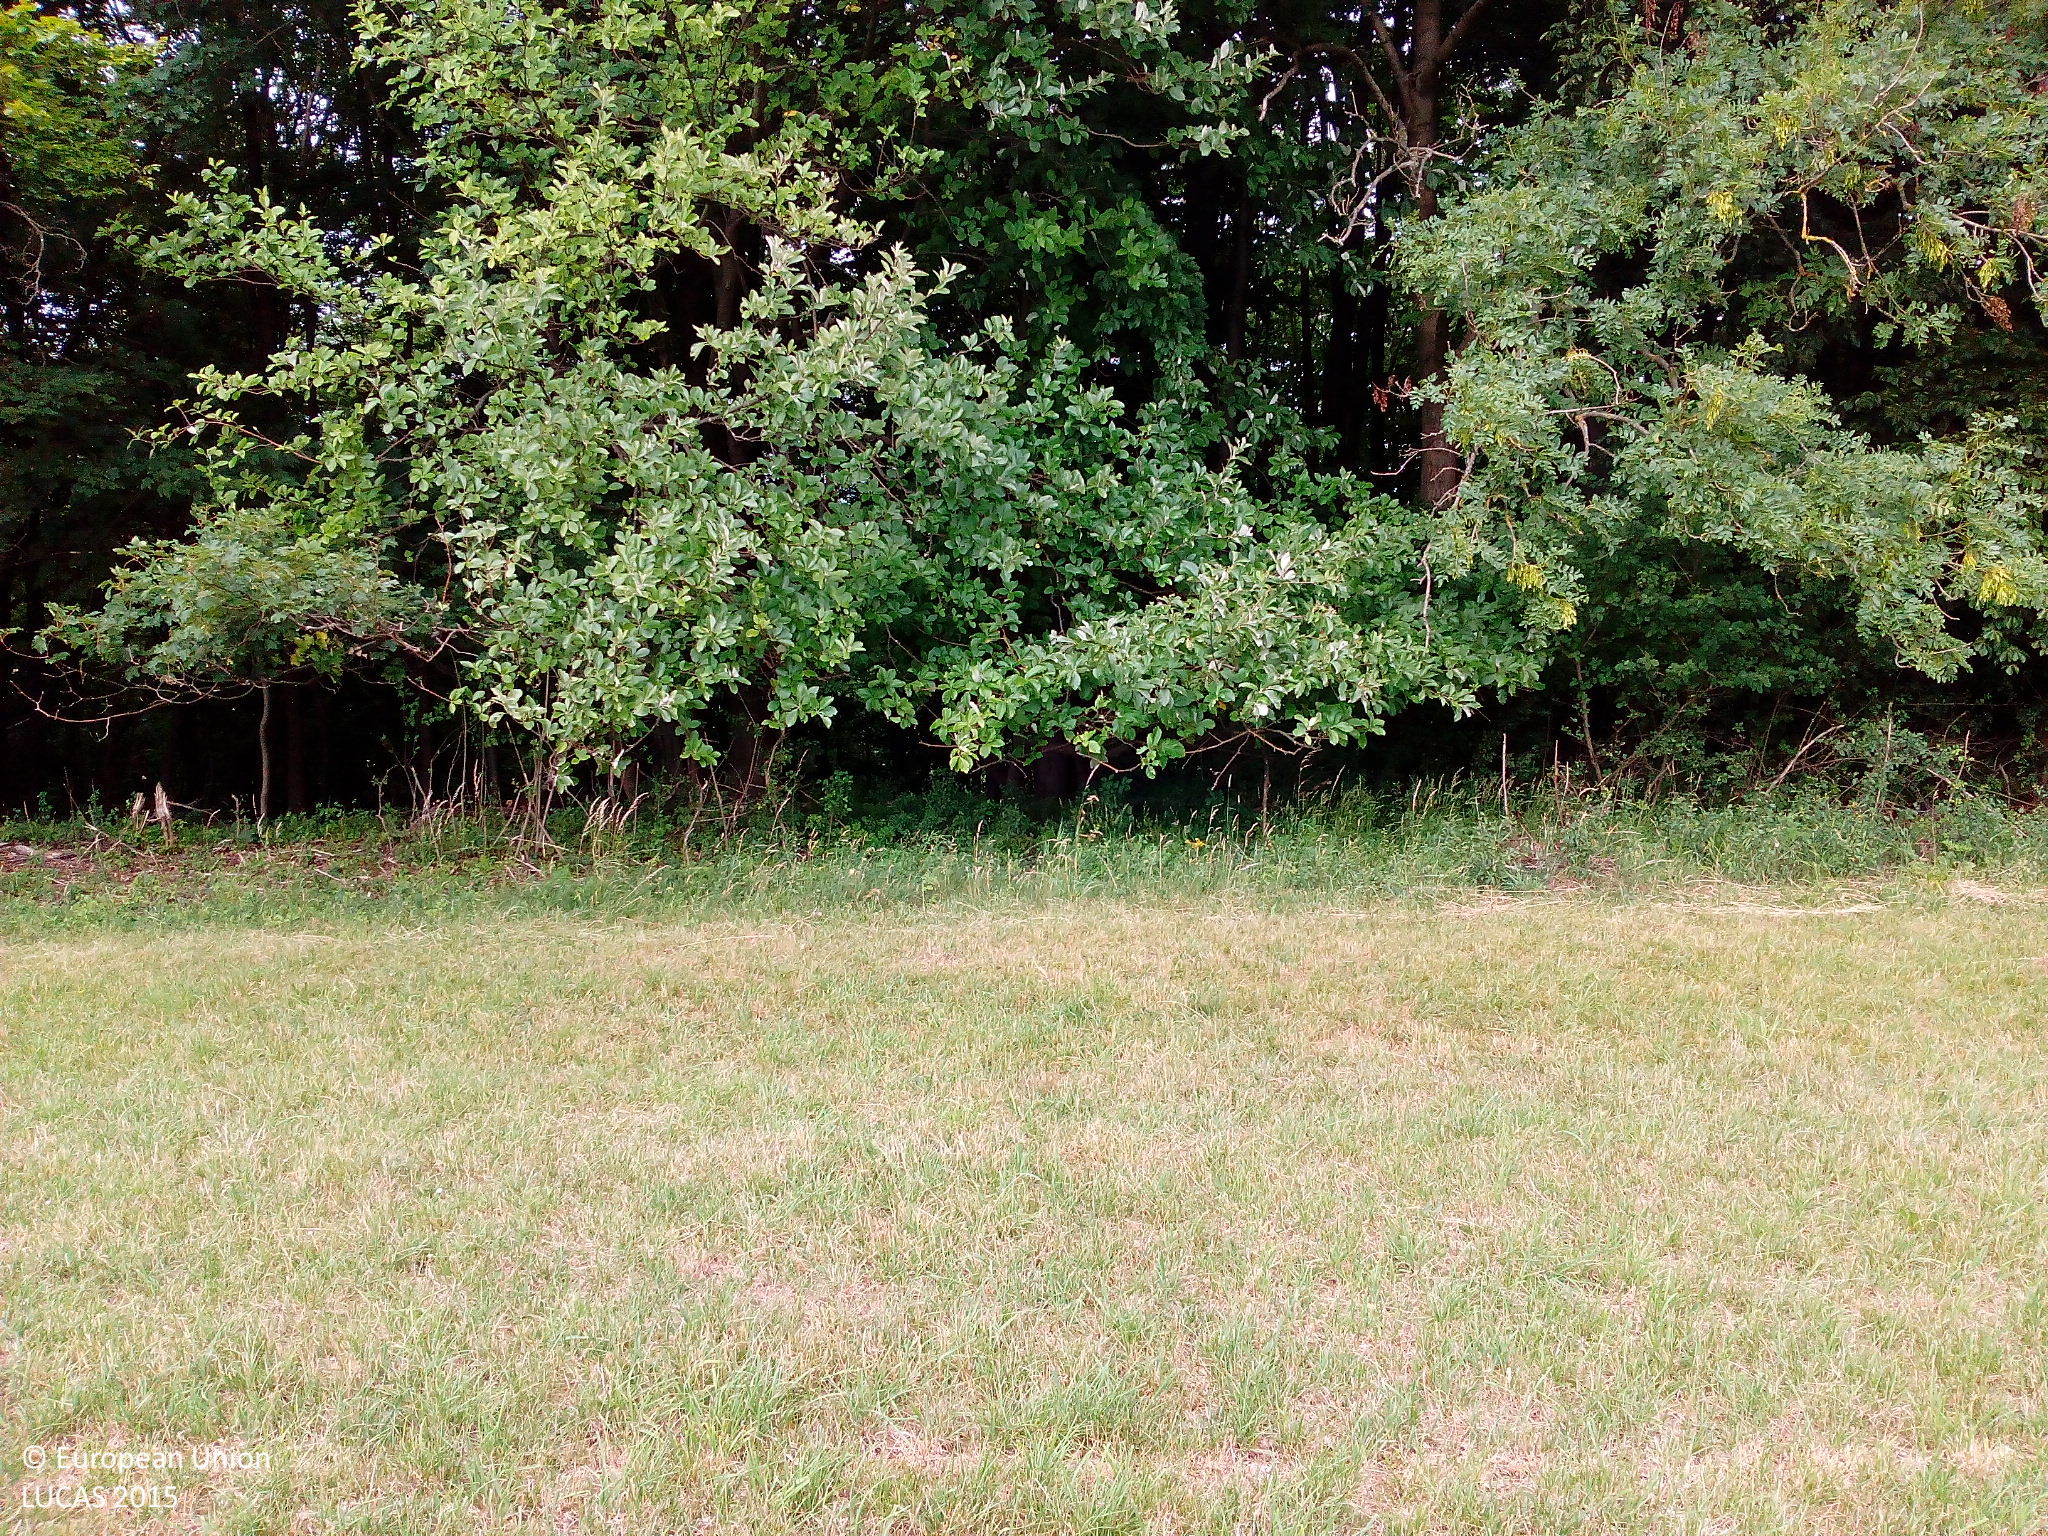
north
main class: Grassland
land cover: Grassland without tree/shrub cover
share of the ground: > 75 %
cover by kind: herbaceous plants 100 %
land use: Agriculture (excluding fallow land and kitchen gardens)
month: July
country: DE
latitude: 50.8135
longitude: 9.9007
